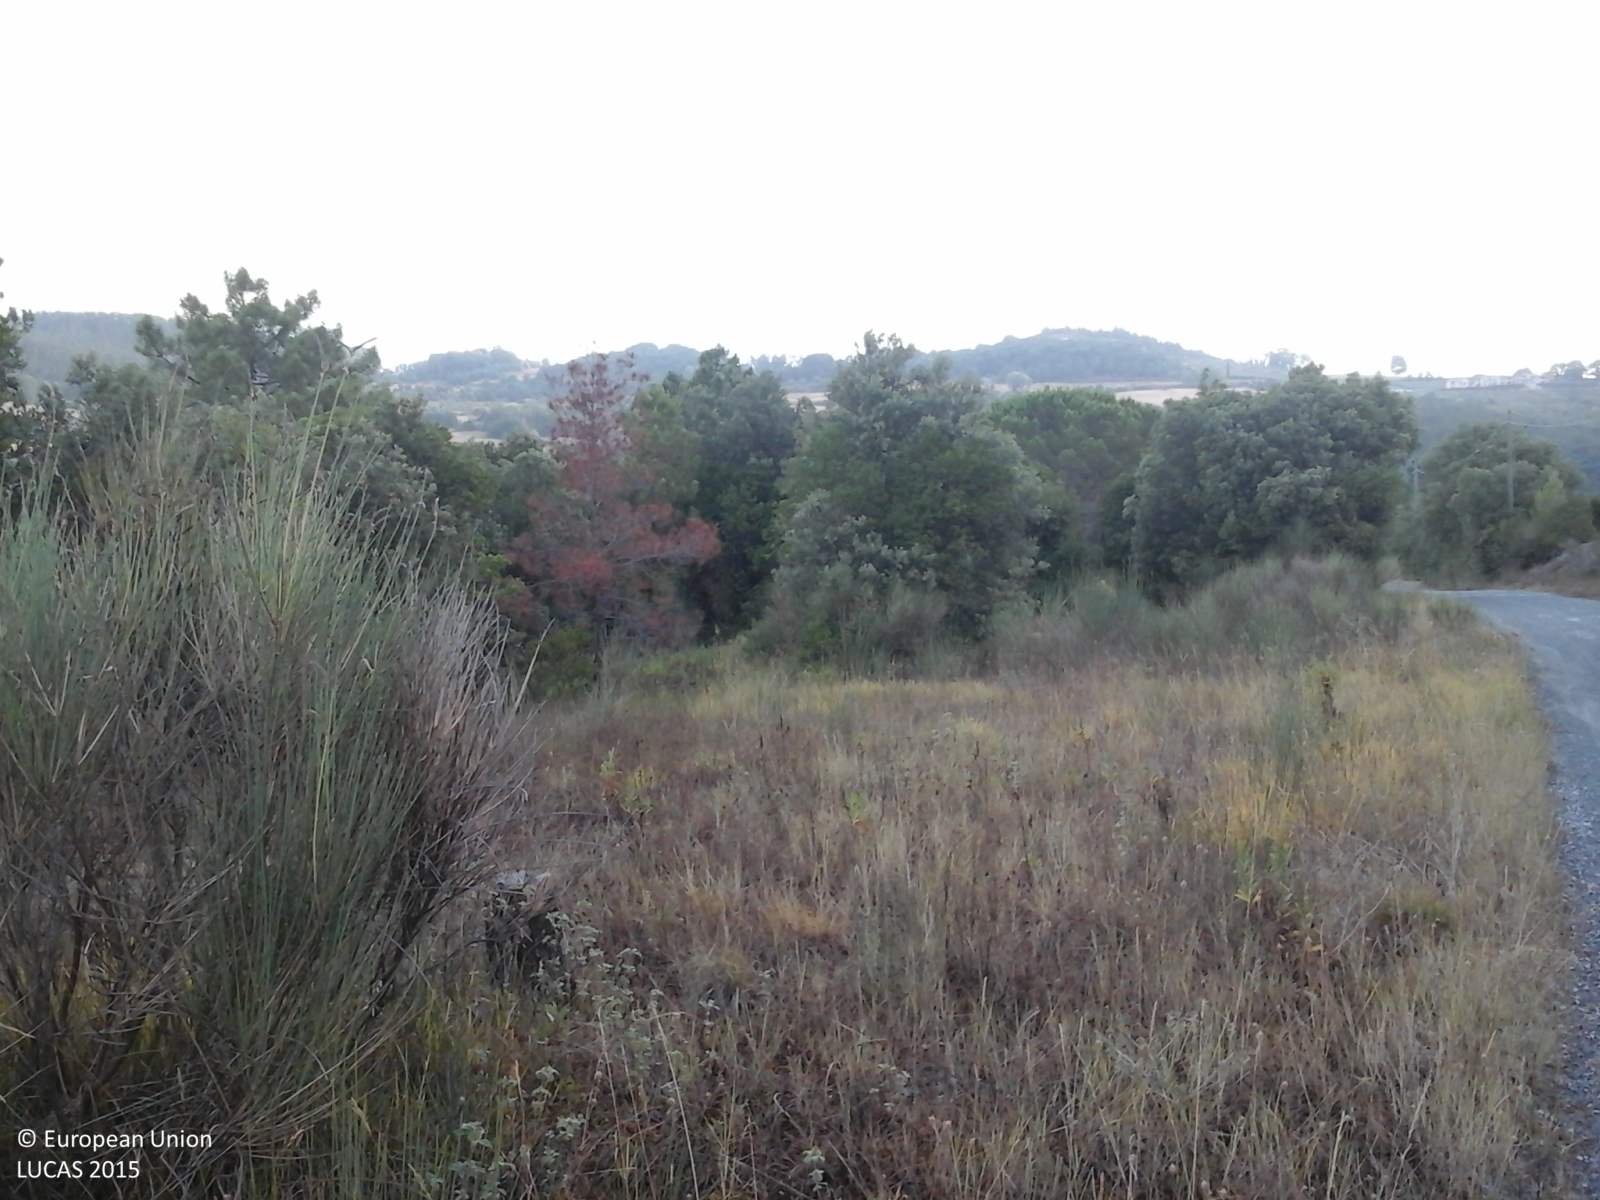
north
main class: Woodland
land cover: Other mixed woodland
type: thermophilous deciduous forest
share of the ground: > 75 %
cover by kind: broadleaved forest trees 60 %, coniferous forest trees 40 %
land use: Forestry
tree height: > 5 m
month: July
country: IT
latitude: 43.4804
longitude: 10.9246
